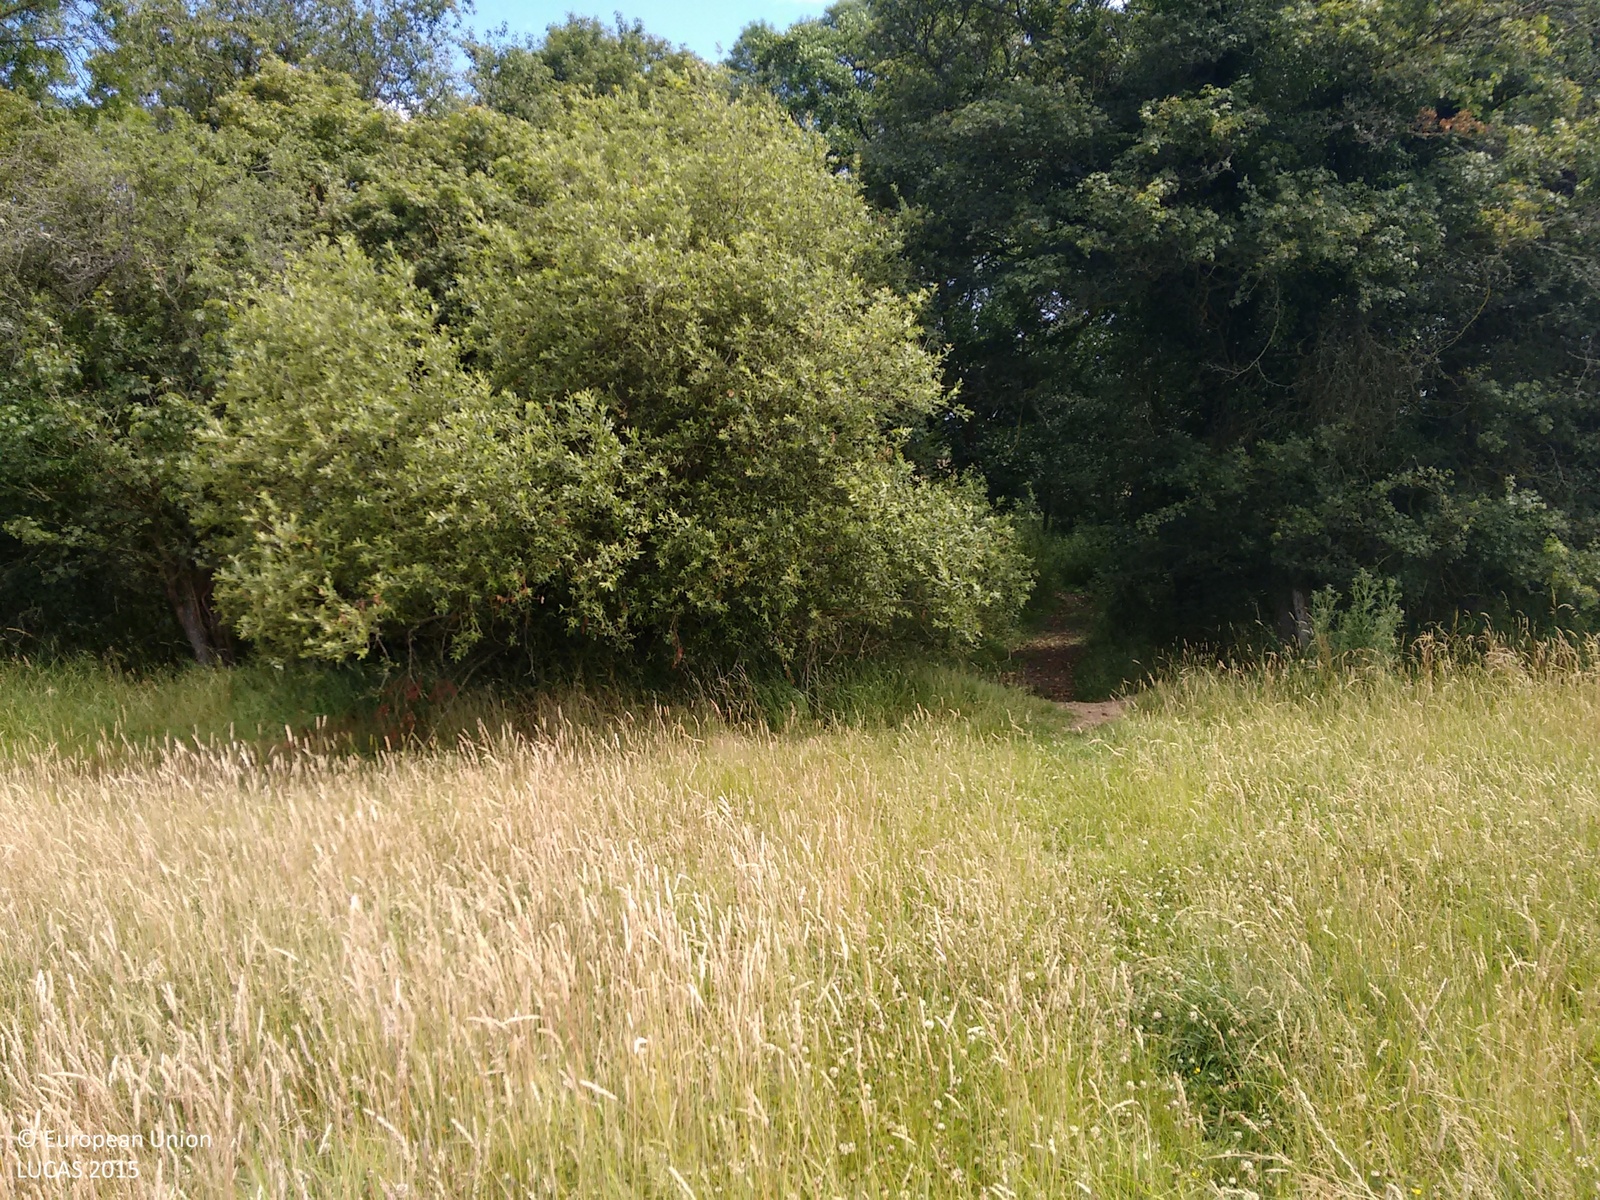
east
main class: Grassland
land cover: Grassland without tree/shrub cover
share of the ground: > 75 %
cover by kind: herbaceous plants 100 %
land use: Agriculture (excluding fallow land and kitchen gardens)
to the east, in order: Grassland without tree/shrub cover; Broadleaved woodland; Rivers and streams; Broadleaved woodland; Fences; Broadleaved woodland; Grassland without tree/shrub cover
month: July
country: GB
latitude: 50.9951
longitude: -0.3955
